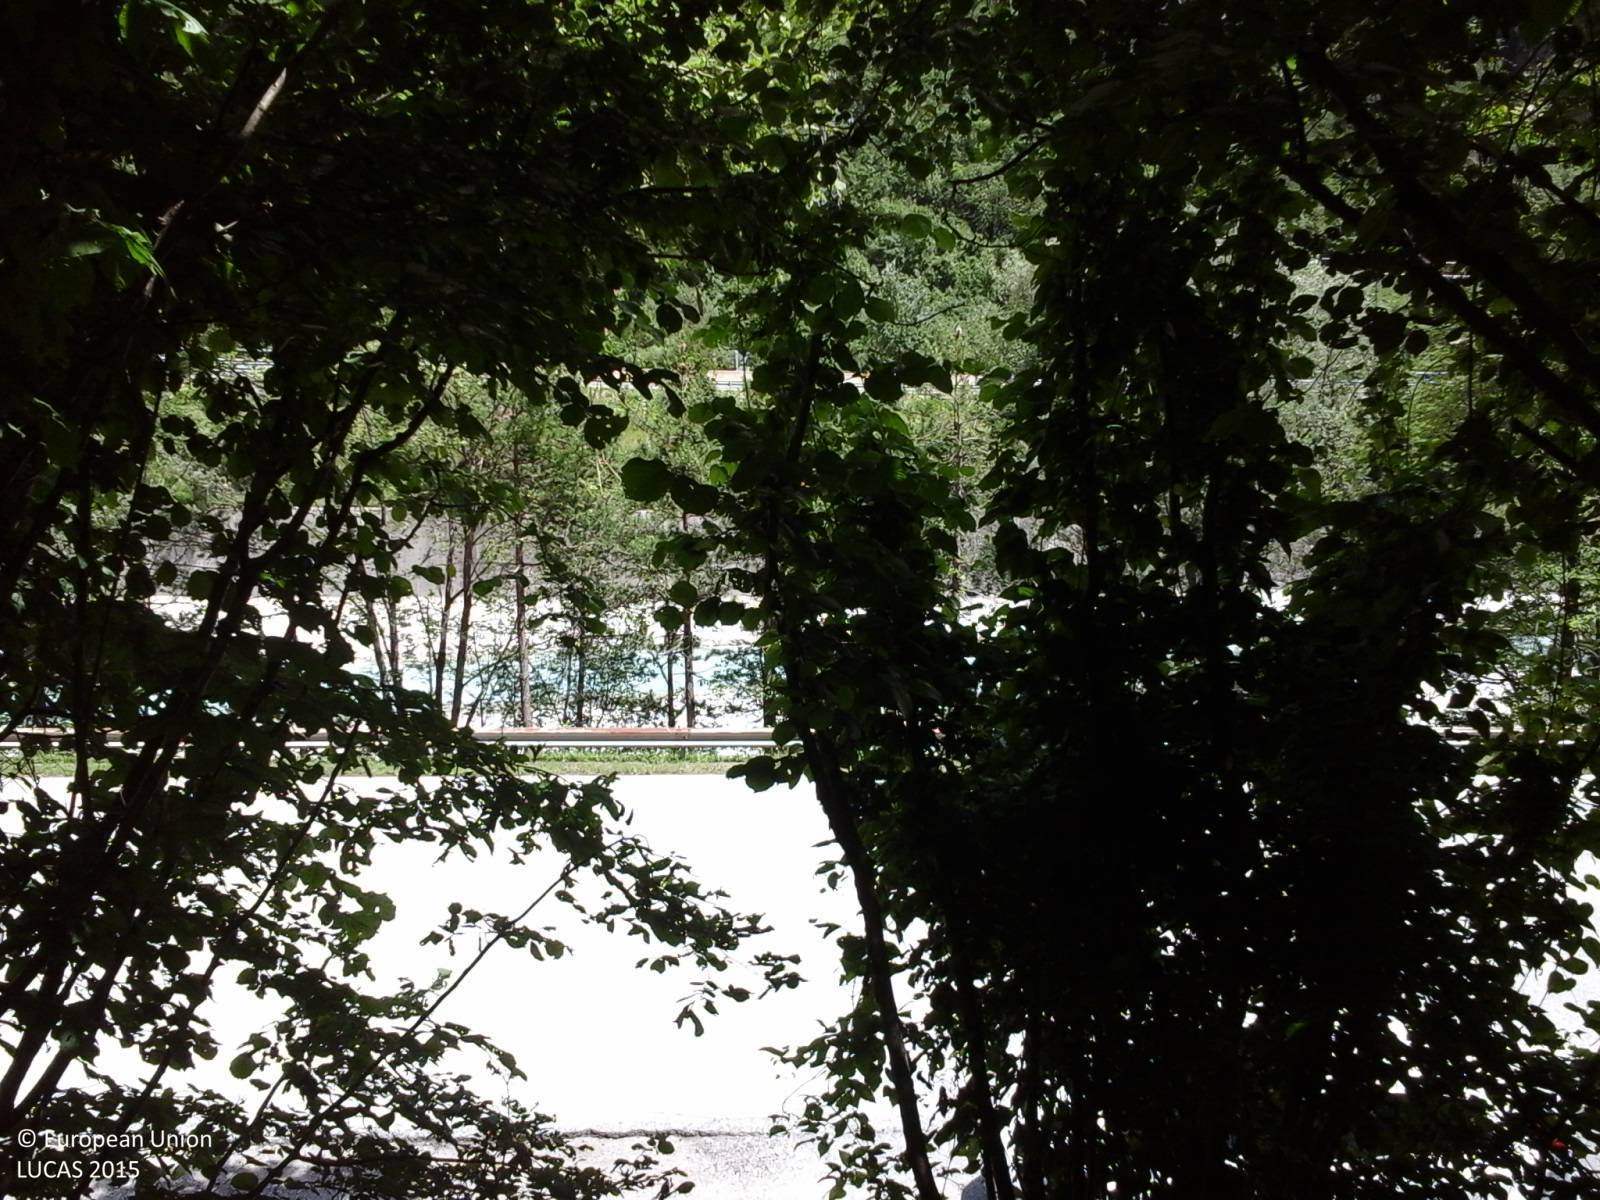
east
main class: Woodland
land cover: Pine dominated coniferous woodland
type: alpine coniferous forest
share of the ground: > 75 %
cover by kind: coniferous forest trees 80 %, broadleaved forest trees 10 %, shrubs 10 %
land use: Forestry
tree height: > 5 m
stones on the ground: 25 - 50 %
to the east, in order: Pine dominated coniferous woodland; Electric lines; Pine dominated coniferous woodland; Fences; Broadleaved woodland; Paved roads, cycling and walking lanes; Grass margins; Abandoned hedges; Inland fresh running water; Grass margins; Managed hedges; Grassland without tree/shrub cover; Paved roads, cycling and walking lanes; Grassland without tree/shrub cover; Fences; Broadleaved woodland; Artificial constructions in urban areas
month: June
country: IT
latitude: 46.4260
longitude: 13.3151
